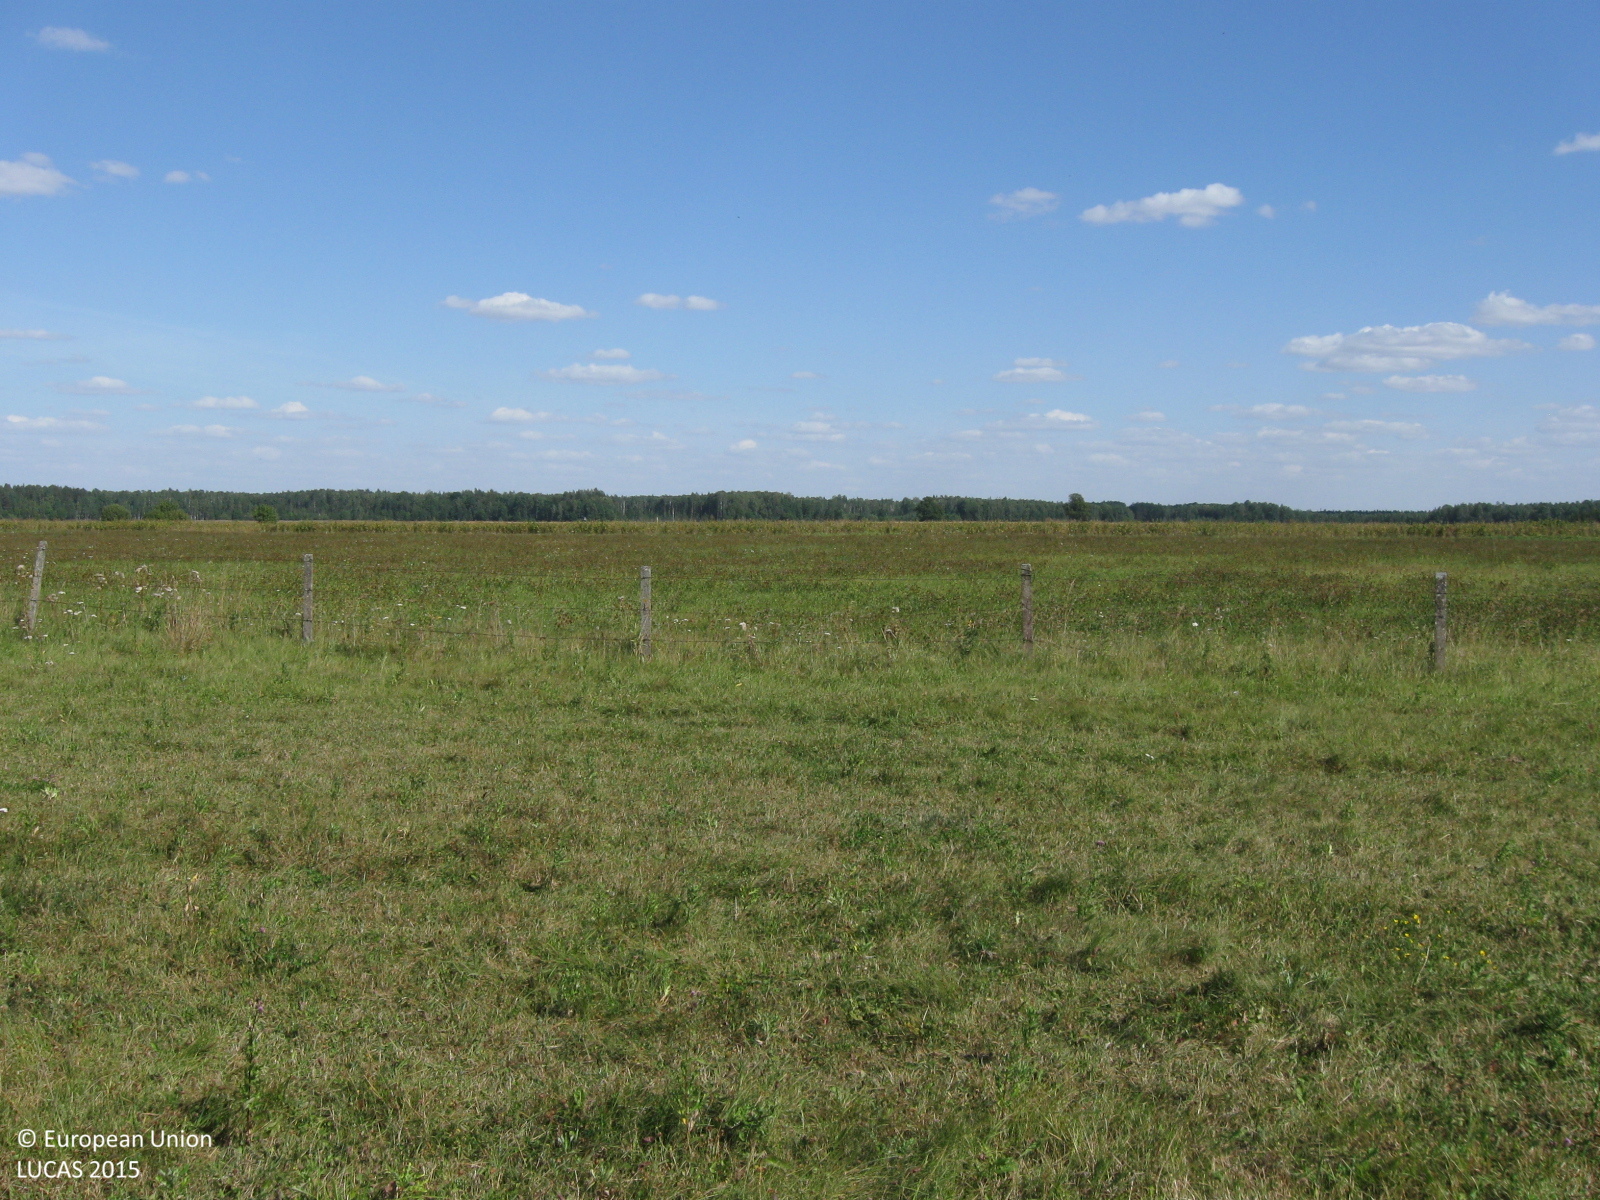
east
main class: Grassland
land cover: Grassland without tree/shrub cover
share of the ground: > 75 %
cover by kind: herbaceous plants 100 %
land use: Agriculture (excluding fallow land and kitchen gardens)
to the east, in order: Grassland without tree/shrub cover; Fences; Grass margins; Other leguminous and mixtures for fodder; Tracks; Other leguminous and mixtures for fodder; Other fruit trees and berries; Grassland without tree/shrub cover
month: August
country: LT
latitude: 55.2276
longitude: 22.4981
